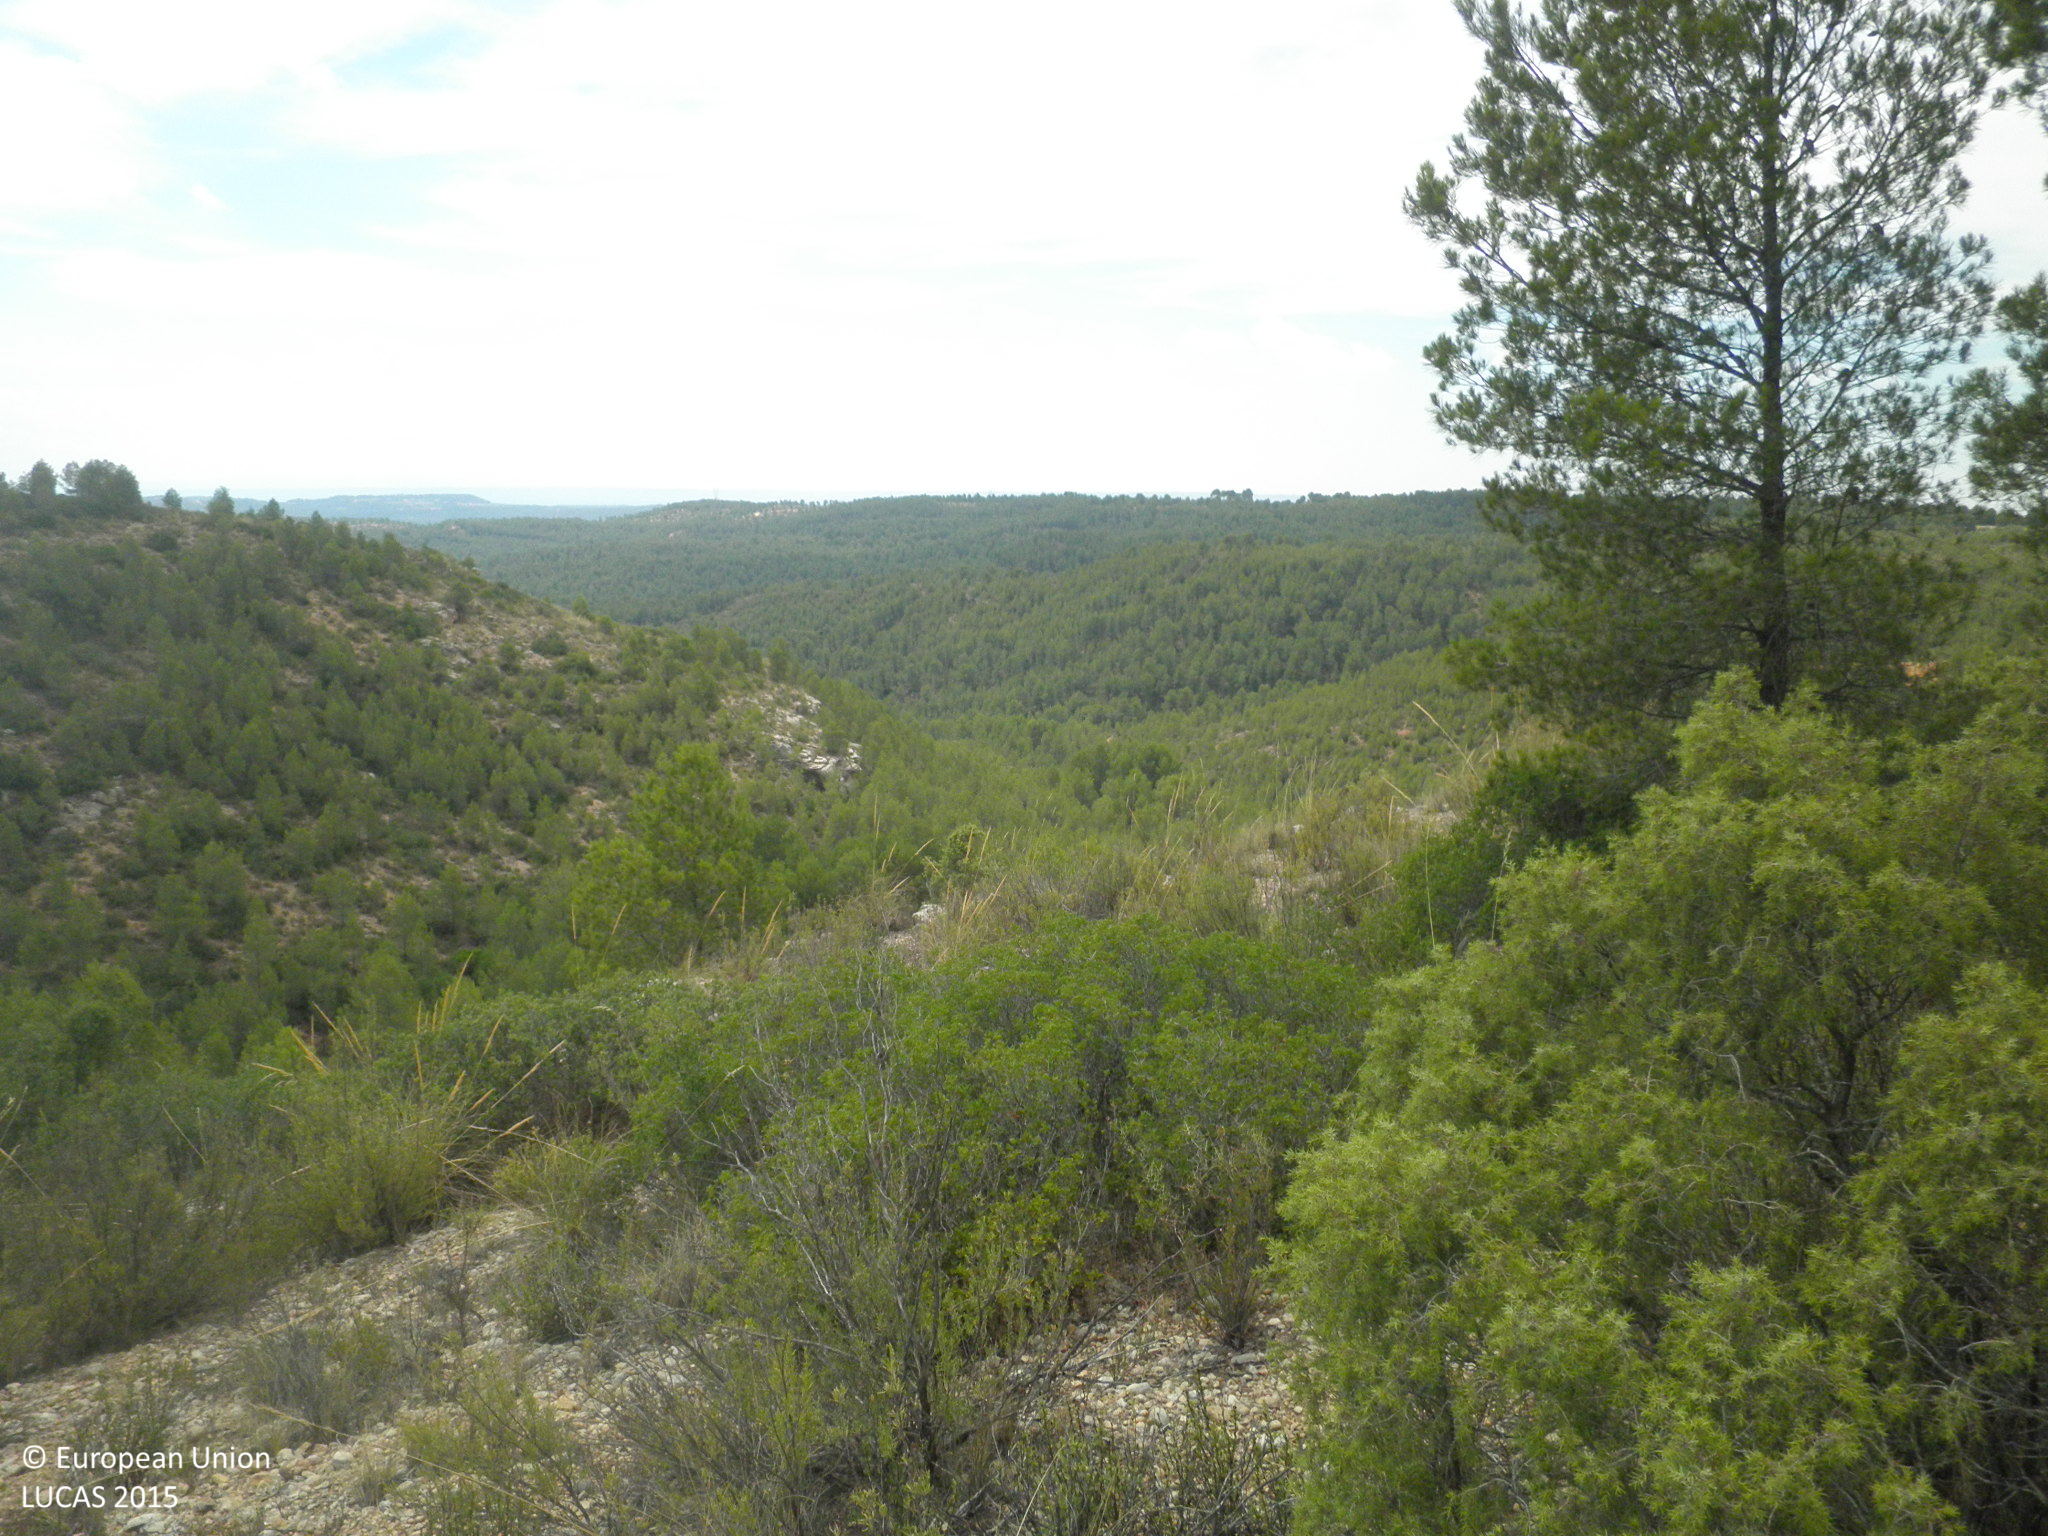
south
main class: Woodland
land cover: Pine dominated coniferous woodland
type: coniferous forest of the mediterranean region
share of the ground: 10 - 25 %
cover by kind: unconsolidated bare surface 45 %, shrubs 40 %, coniferous forest trees 10 %, herbaceous plants 5 %
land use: Semi-natural and natural areas not in use
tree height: < 5 m
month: July
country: ES
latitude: 39.5299
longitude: -1.5338
